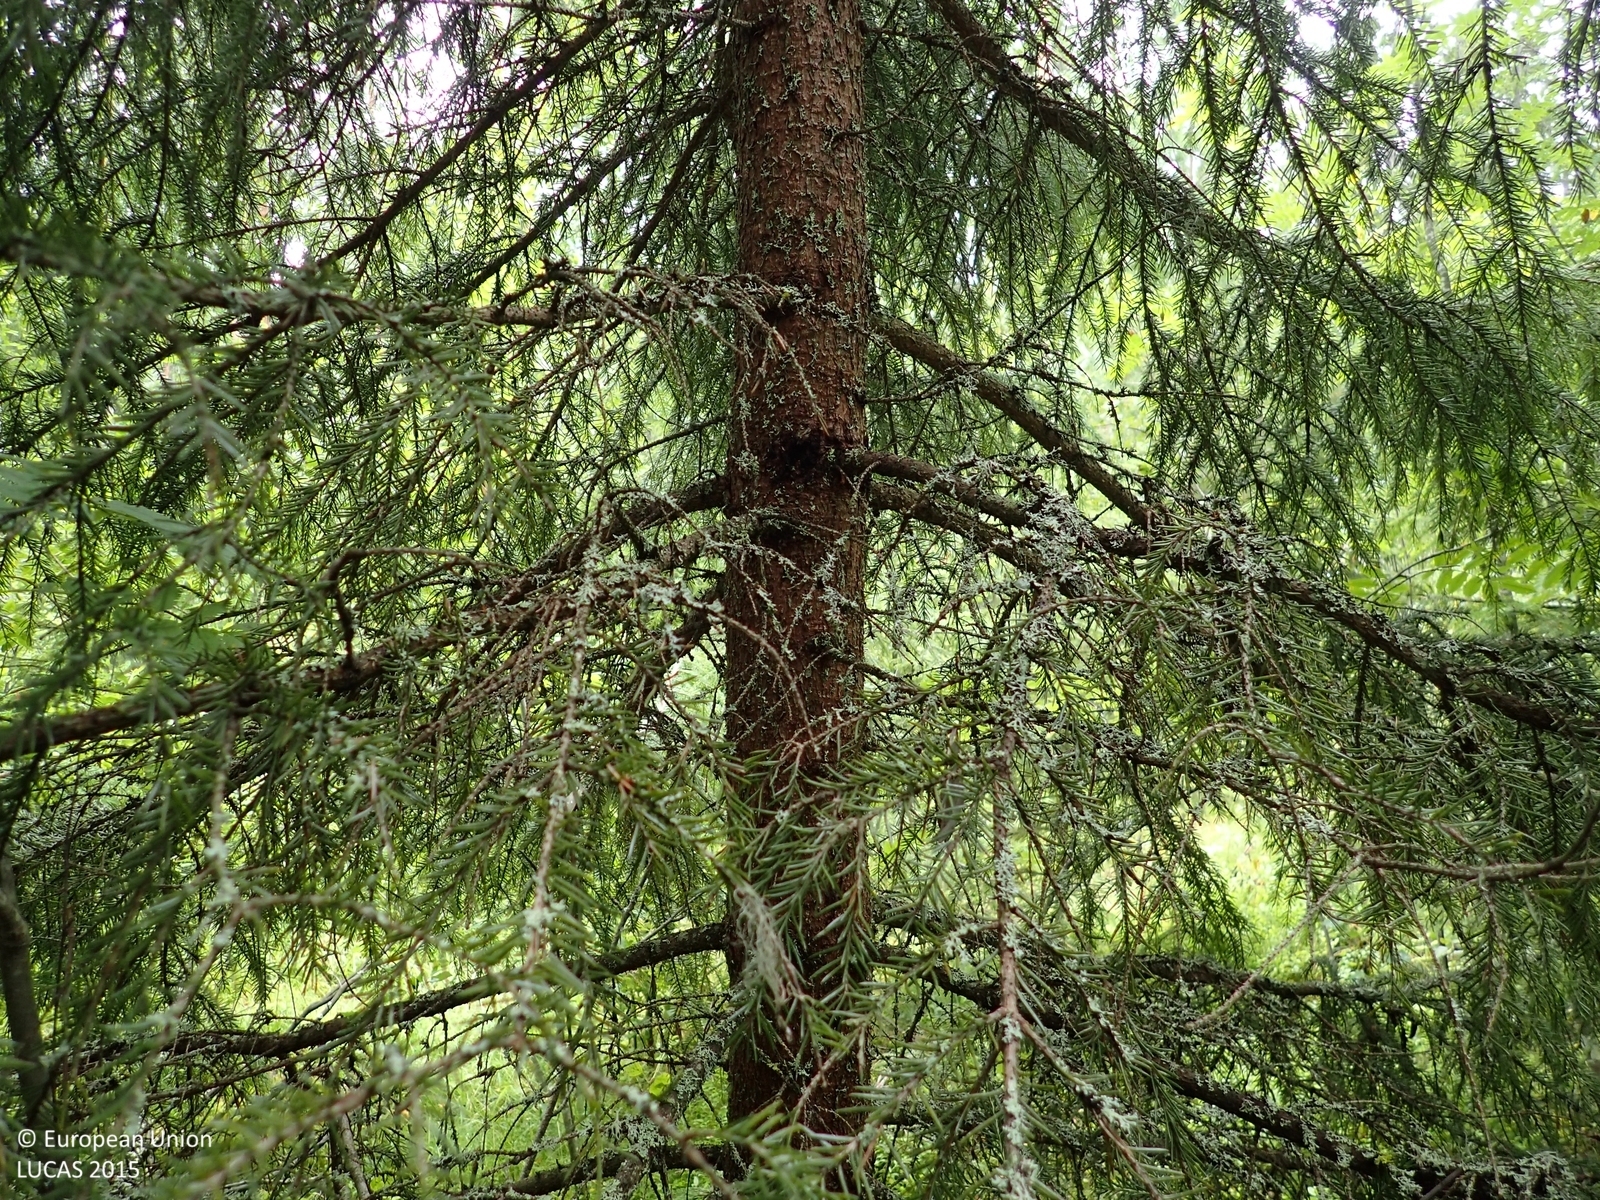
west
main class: Woodland
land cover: Spruce dominated mixed woodland
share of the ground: > 75 %
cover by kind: broadleaved forest trees 60 %, coniferous forest trees 20 %, shrubs 10 %, herbaceous plants 5 %, lichens and mosses 5 %
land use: Forestry
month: July
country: FI
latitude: 62.9387
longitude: 22.8438
